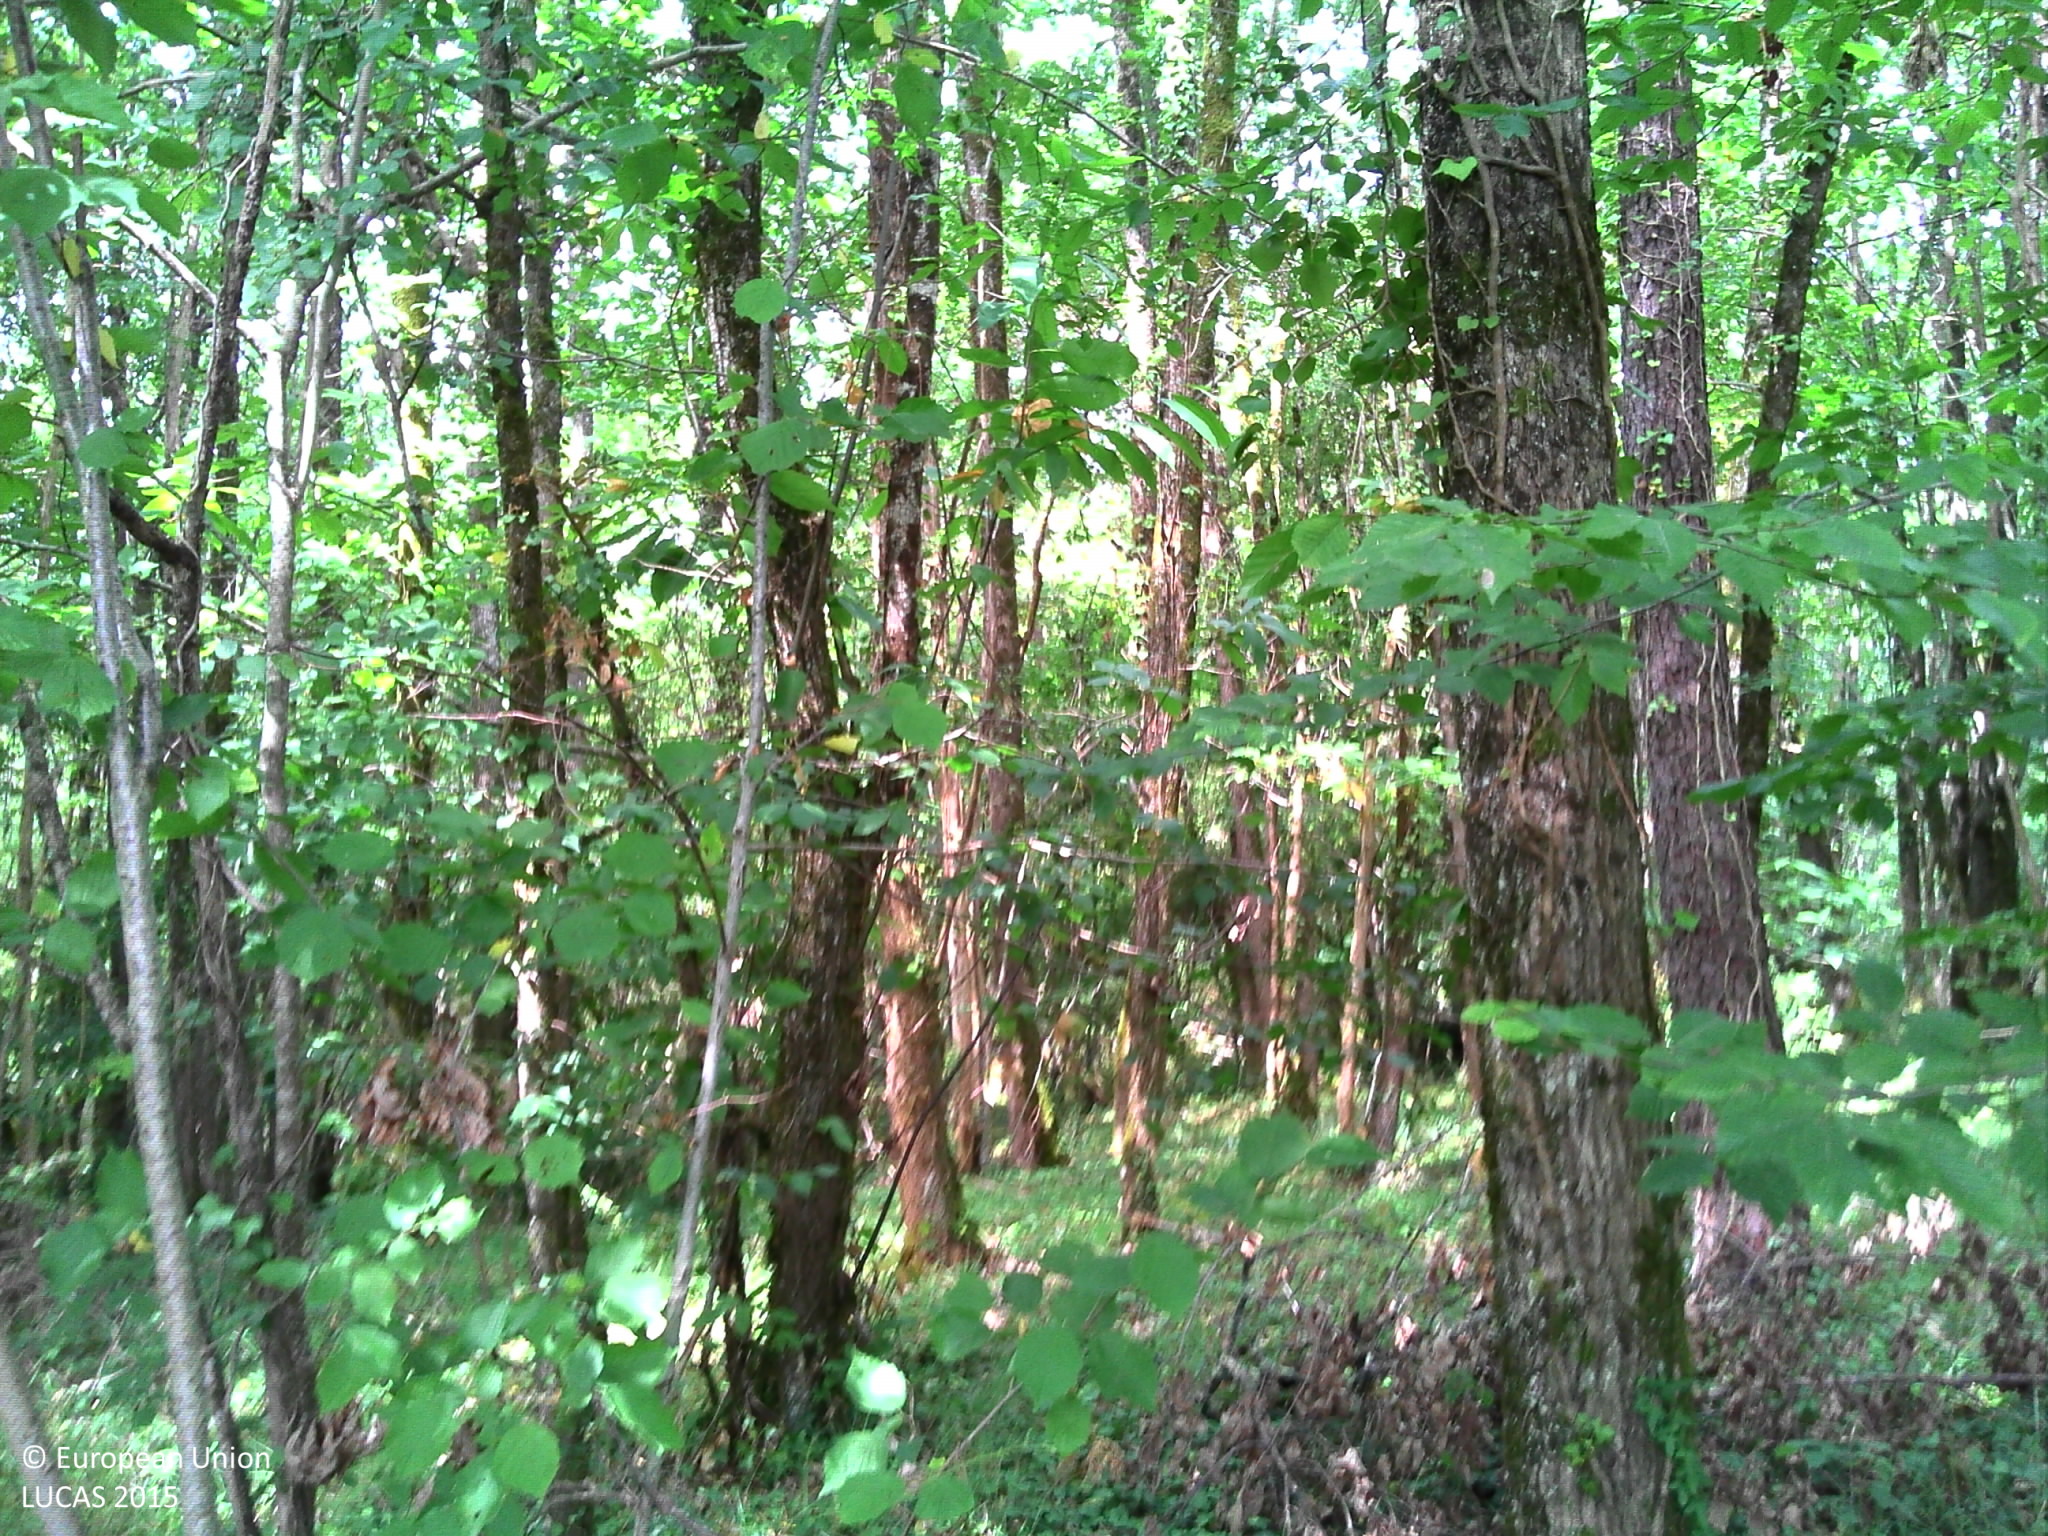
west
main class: Woodland
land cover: Broadleaved woodland
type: thermophilous deciduous forest
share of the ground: > 75 %
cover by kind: broadleaved forest trees 80 %, herbaceous plants 10 %, shrubs 5 %, lichens and mosses 5 %
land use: Forestry
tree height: > 5 m
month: July
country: FR
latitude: 44.9056
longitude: 0.8355
